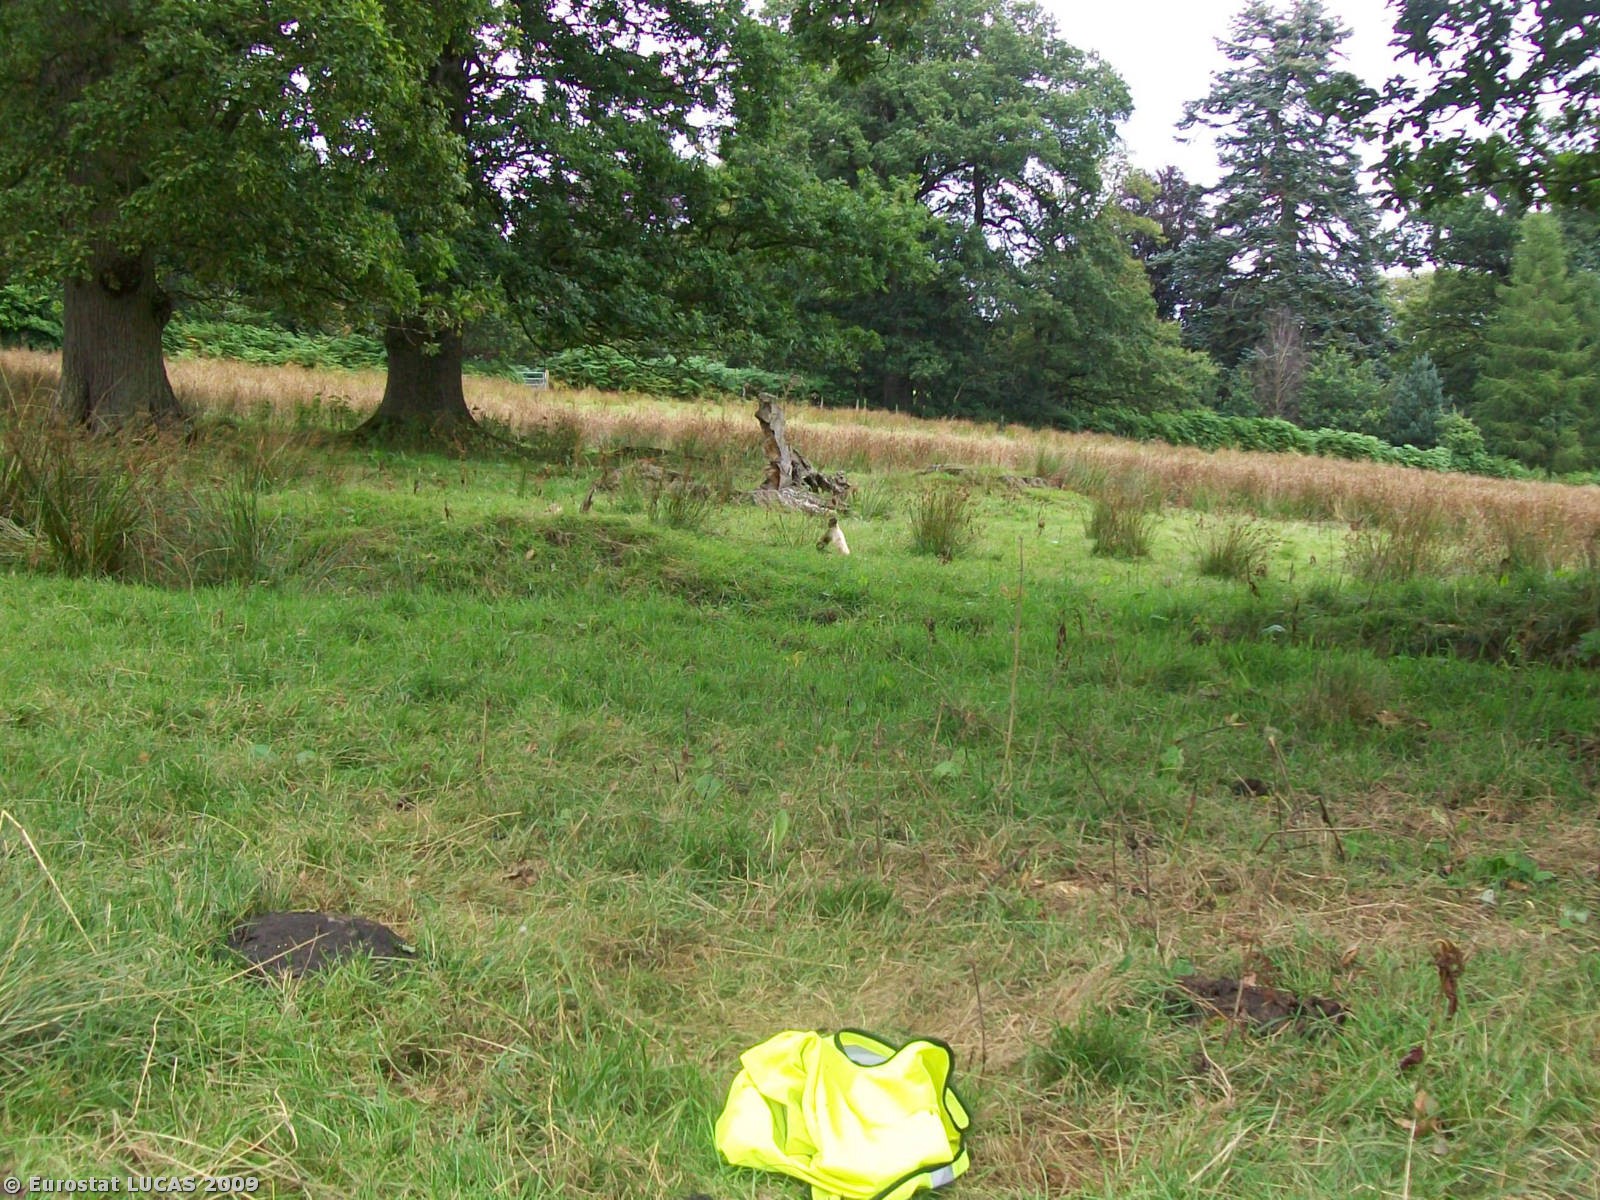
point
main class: Grassland
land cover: Grassland with sparse tree/shrub cover
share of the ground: > 75 %
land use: Agriculture (excluding fallow land and kitchen gardens)
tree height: > 5 m
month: August
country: GB
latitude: 52.5678
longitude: -3.3448
